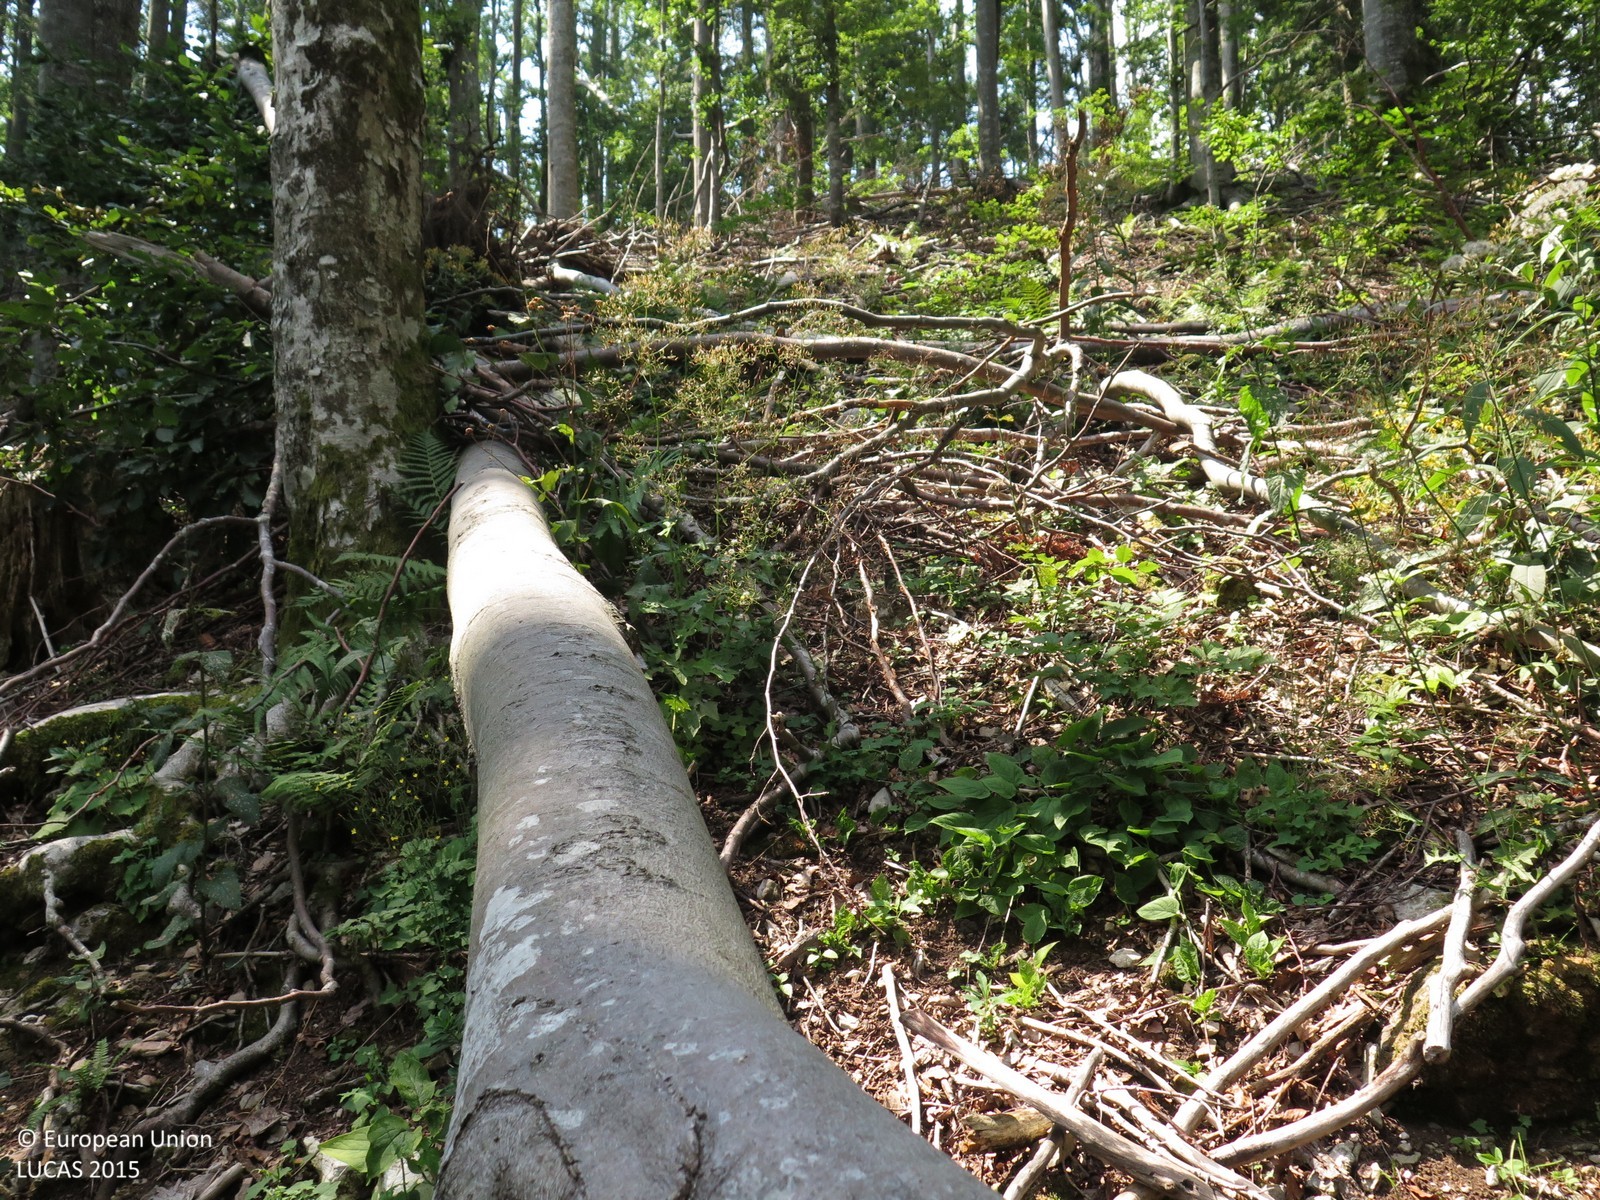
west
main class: Woodland
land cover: Broadleaved woodland
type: mountainous beech forest
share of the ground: > 75 %
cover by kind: broadleaved forest trees 95 %, herbaceous plants 5 %
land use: Forestry
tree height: > 5 m
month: August
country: HR
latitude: 45.4949
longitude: 14.5893
